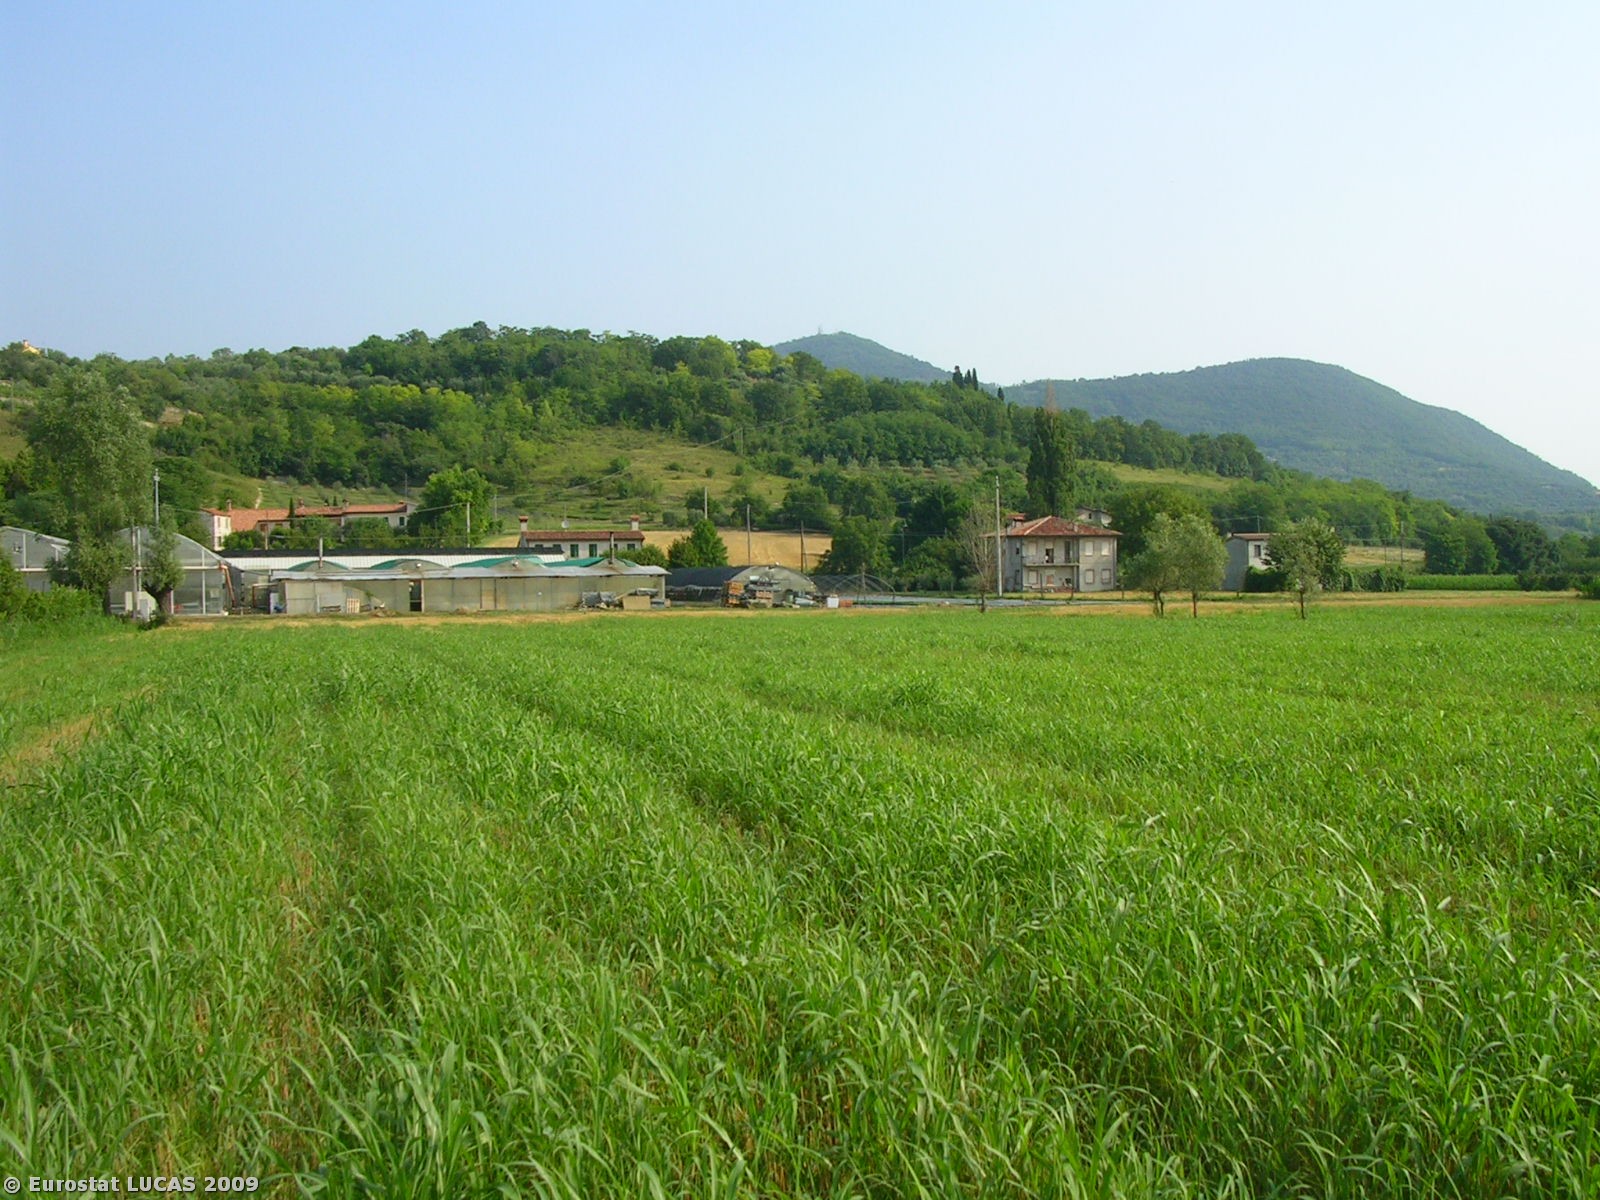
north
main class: Cropland
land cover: Common wheat
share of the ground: > 75 %
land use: Agriculture (excluding fallow land and kitchen gardens)
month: July
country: IT
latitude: 45.2561
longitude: 11.7173
